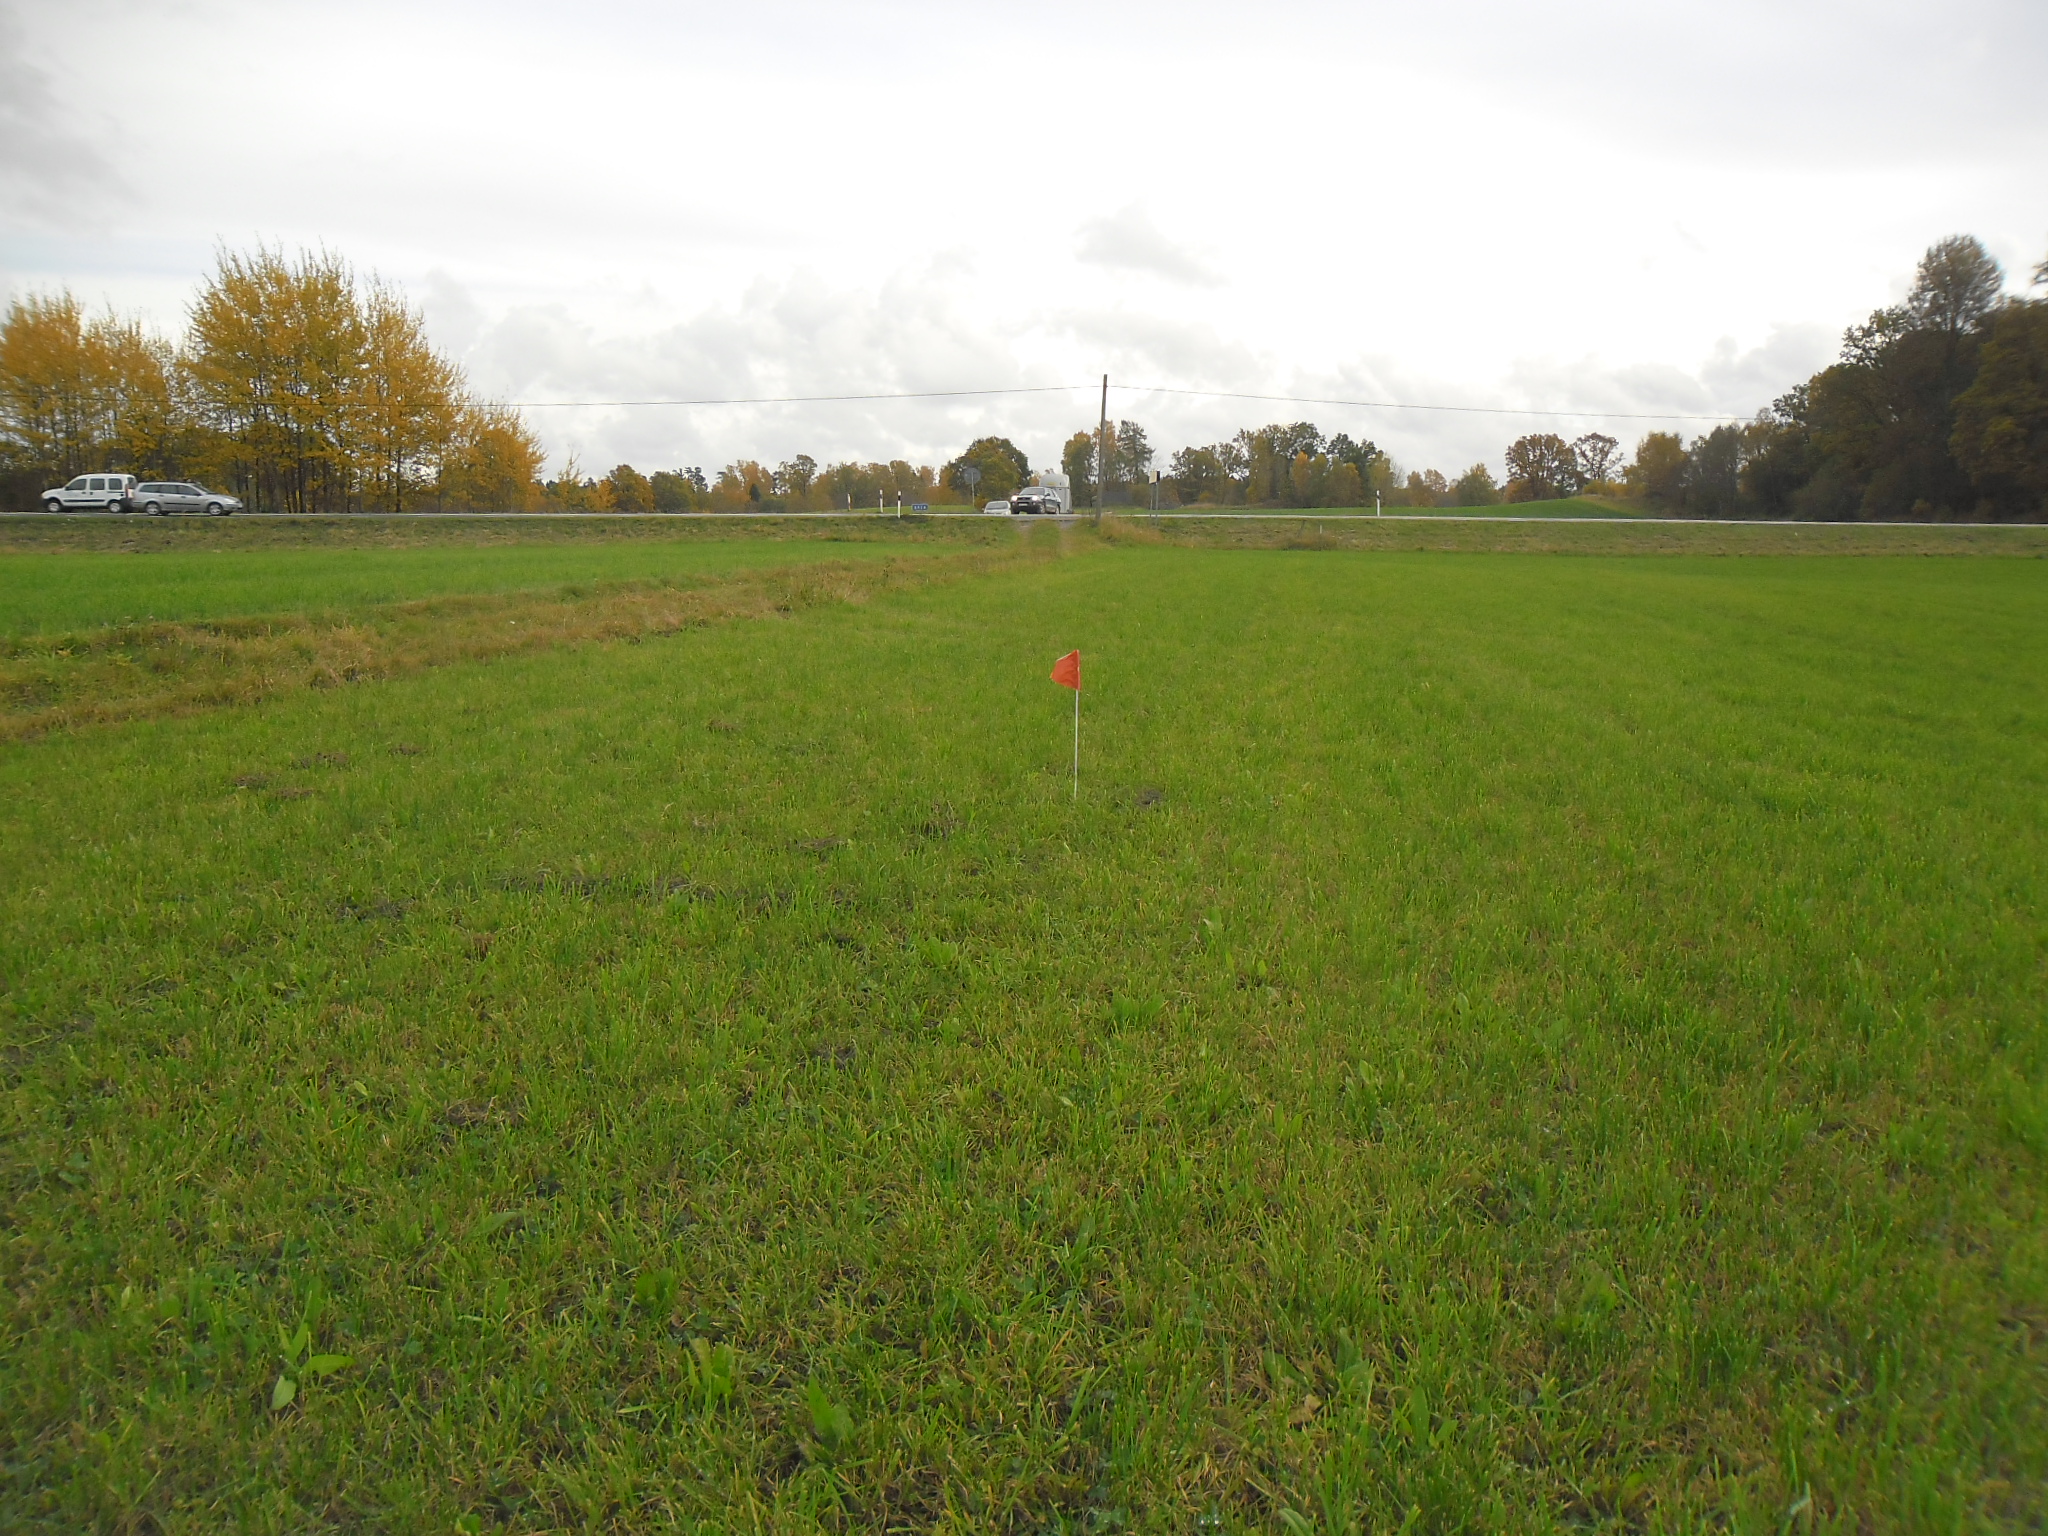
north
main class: Grassland
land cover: Grassland without tree/shrub cover
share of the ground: > 75 %
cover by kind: herbaceous plants 100 %
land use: Agriculture (excluding fallow land and kitchen gardens)
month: October
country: SE
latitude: 56.0443
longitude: 13.7059
